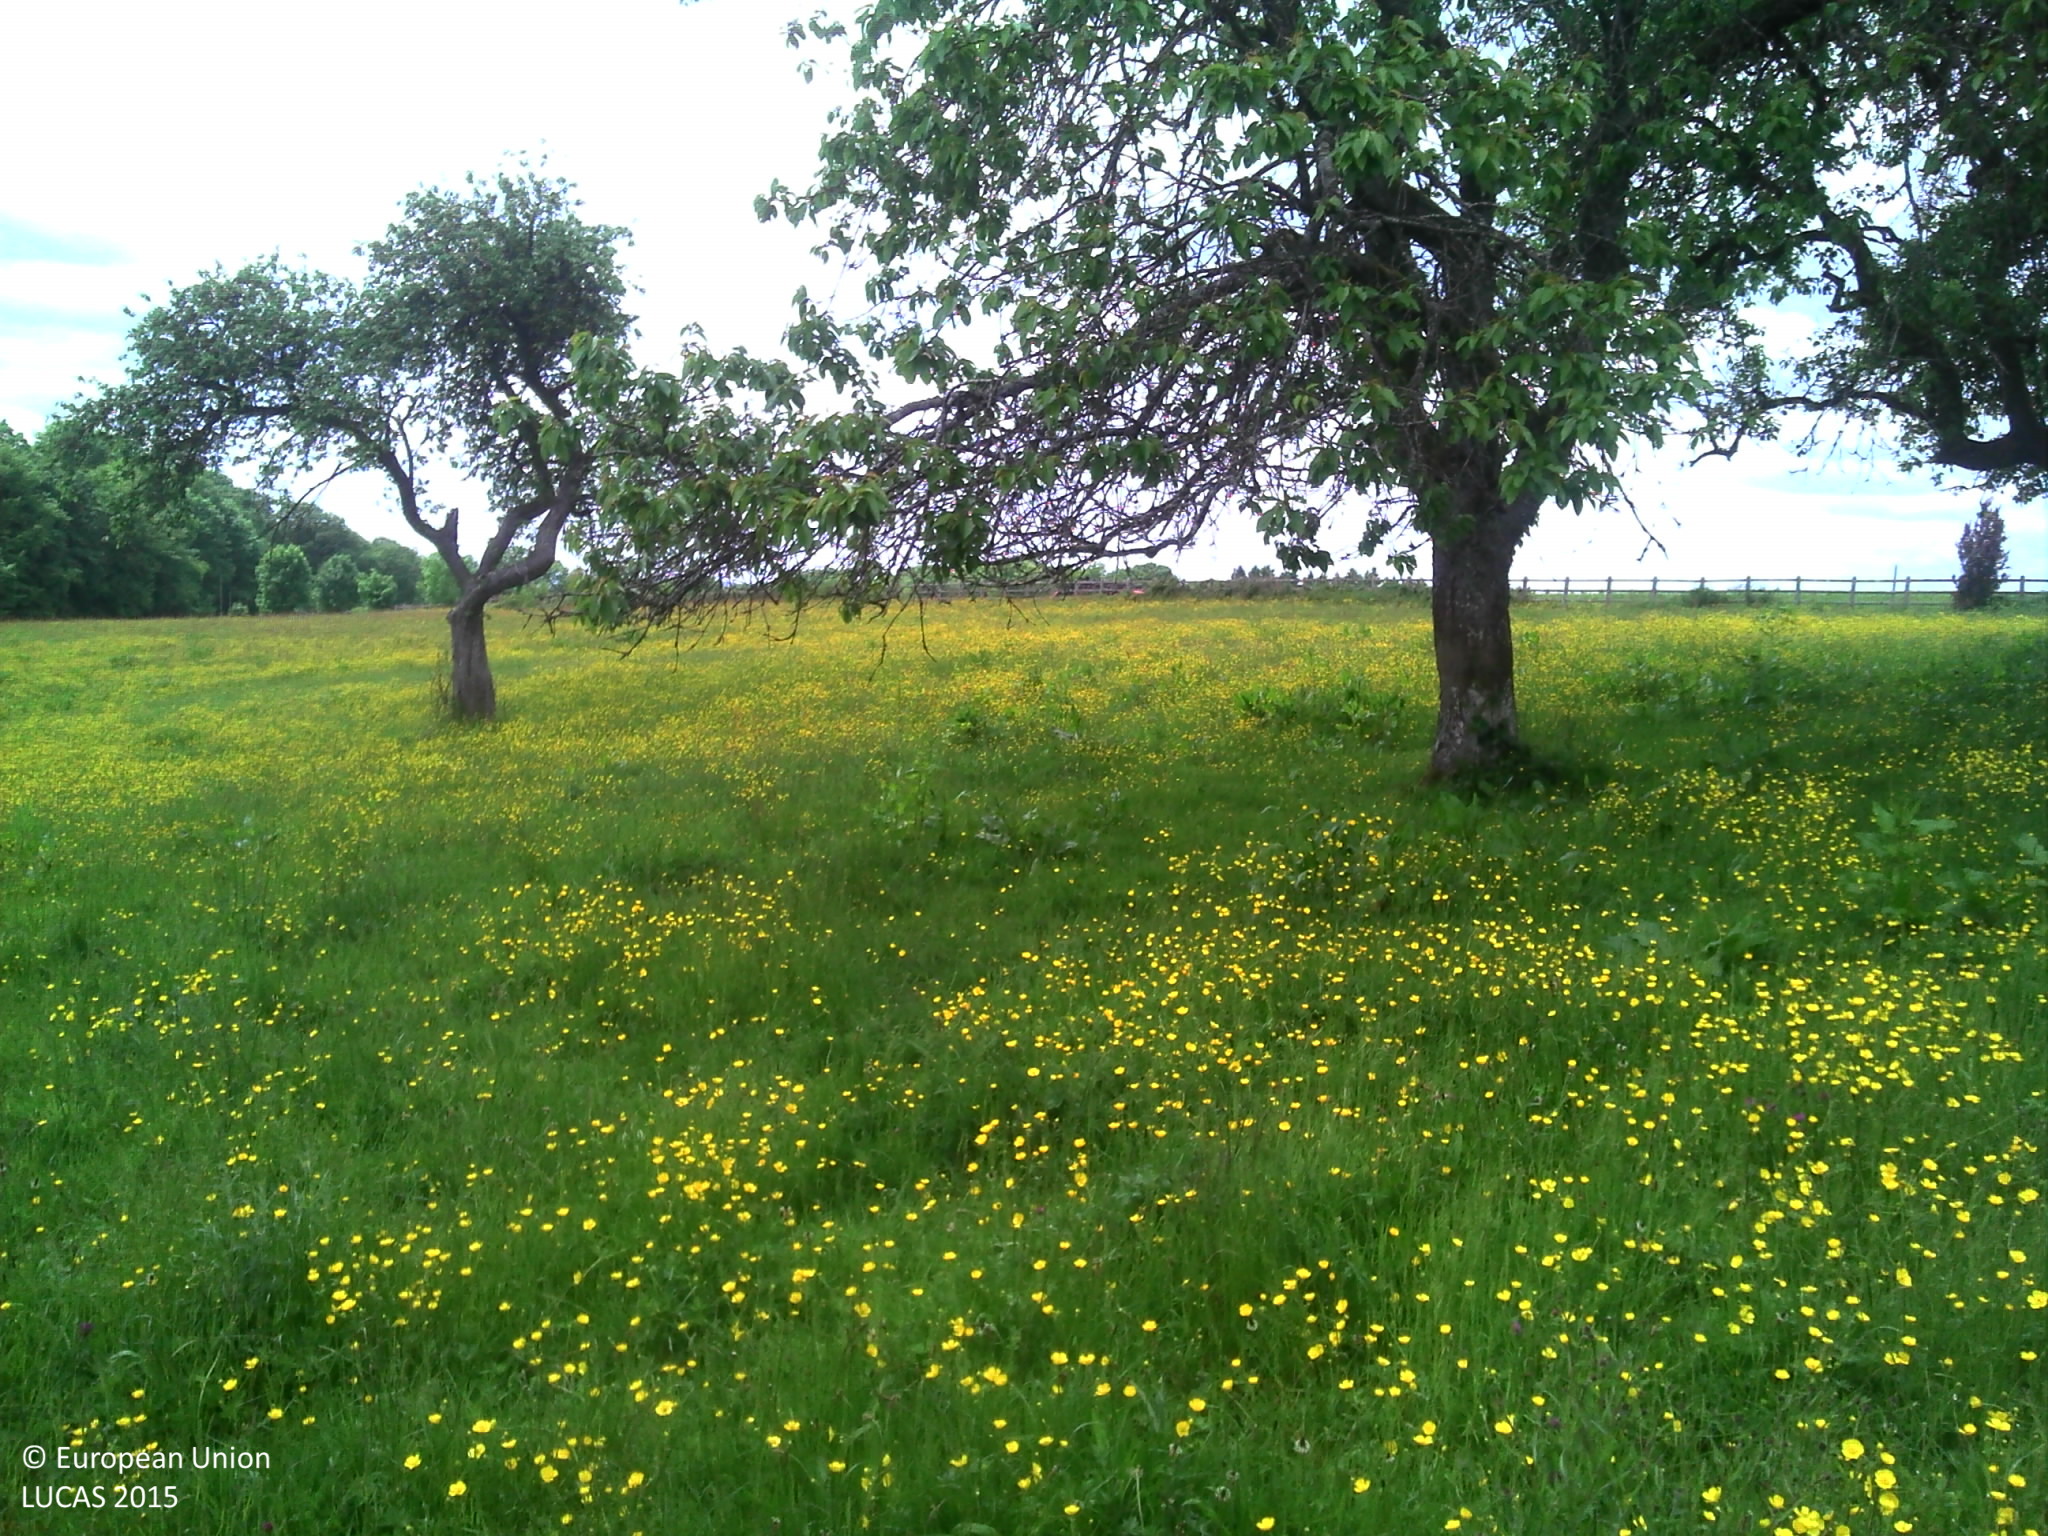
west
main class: Grassland
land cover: Grassland with sparse tree/shrub cover
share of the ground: > 75 %
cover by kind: herbaceous plants 90 %, broadleaved forest trees 5 %, unconsolidated bare surface 5 %
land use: Residential
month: June
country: BE
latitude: 49.8177
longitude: 4.8964
